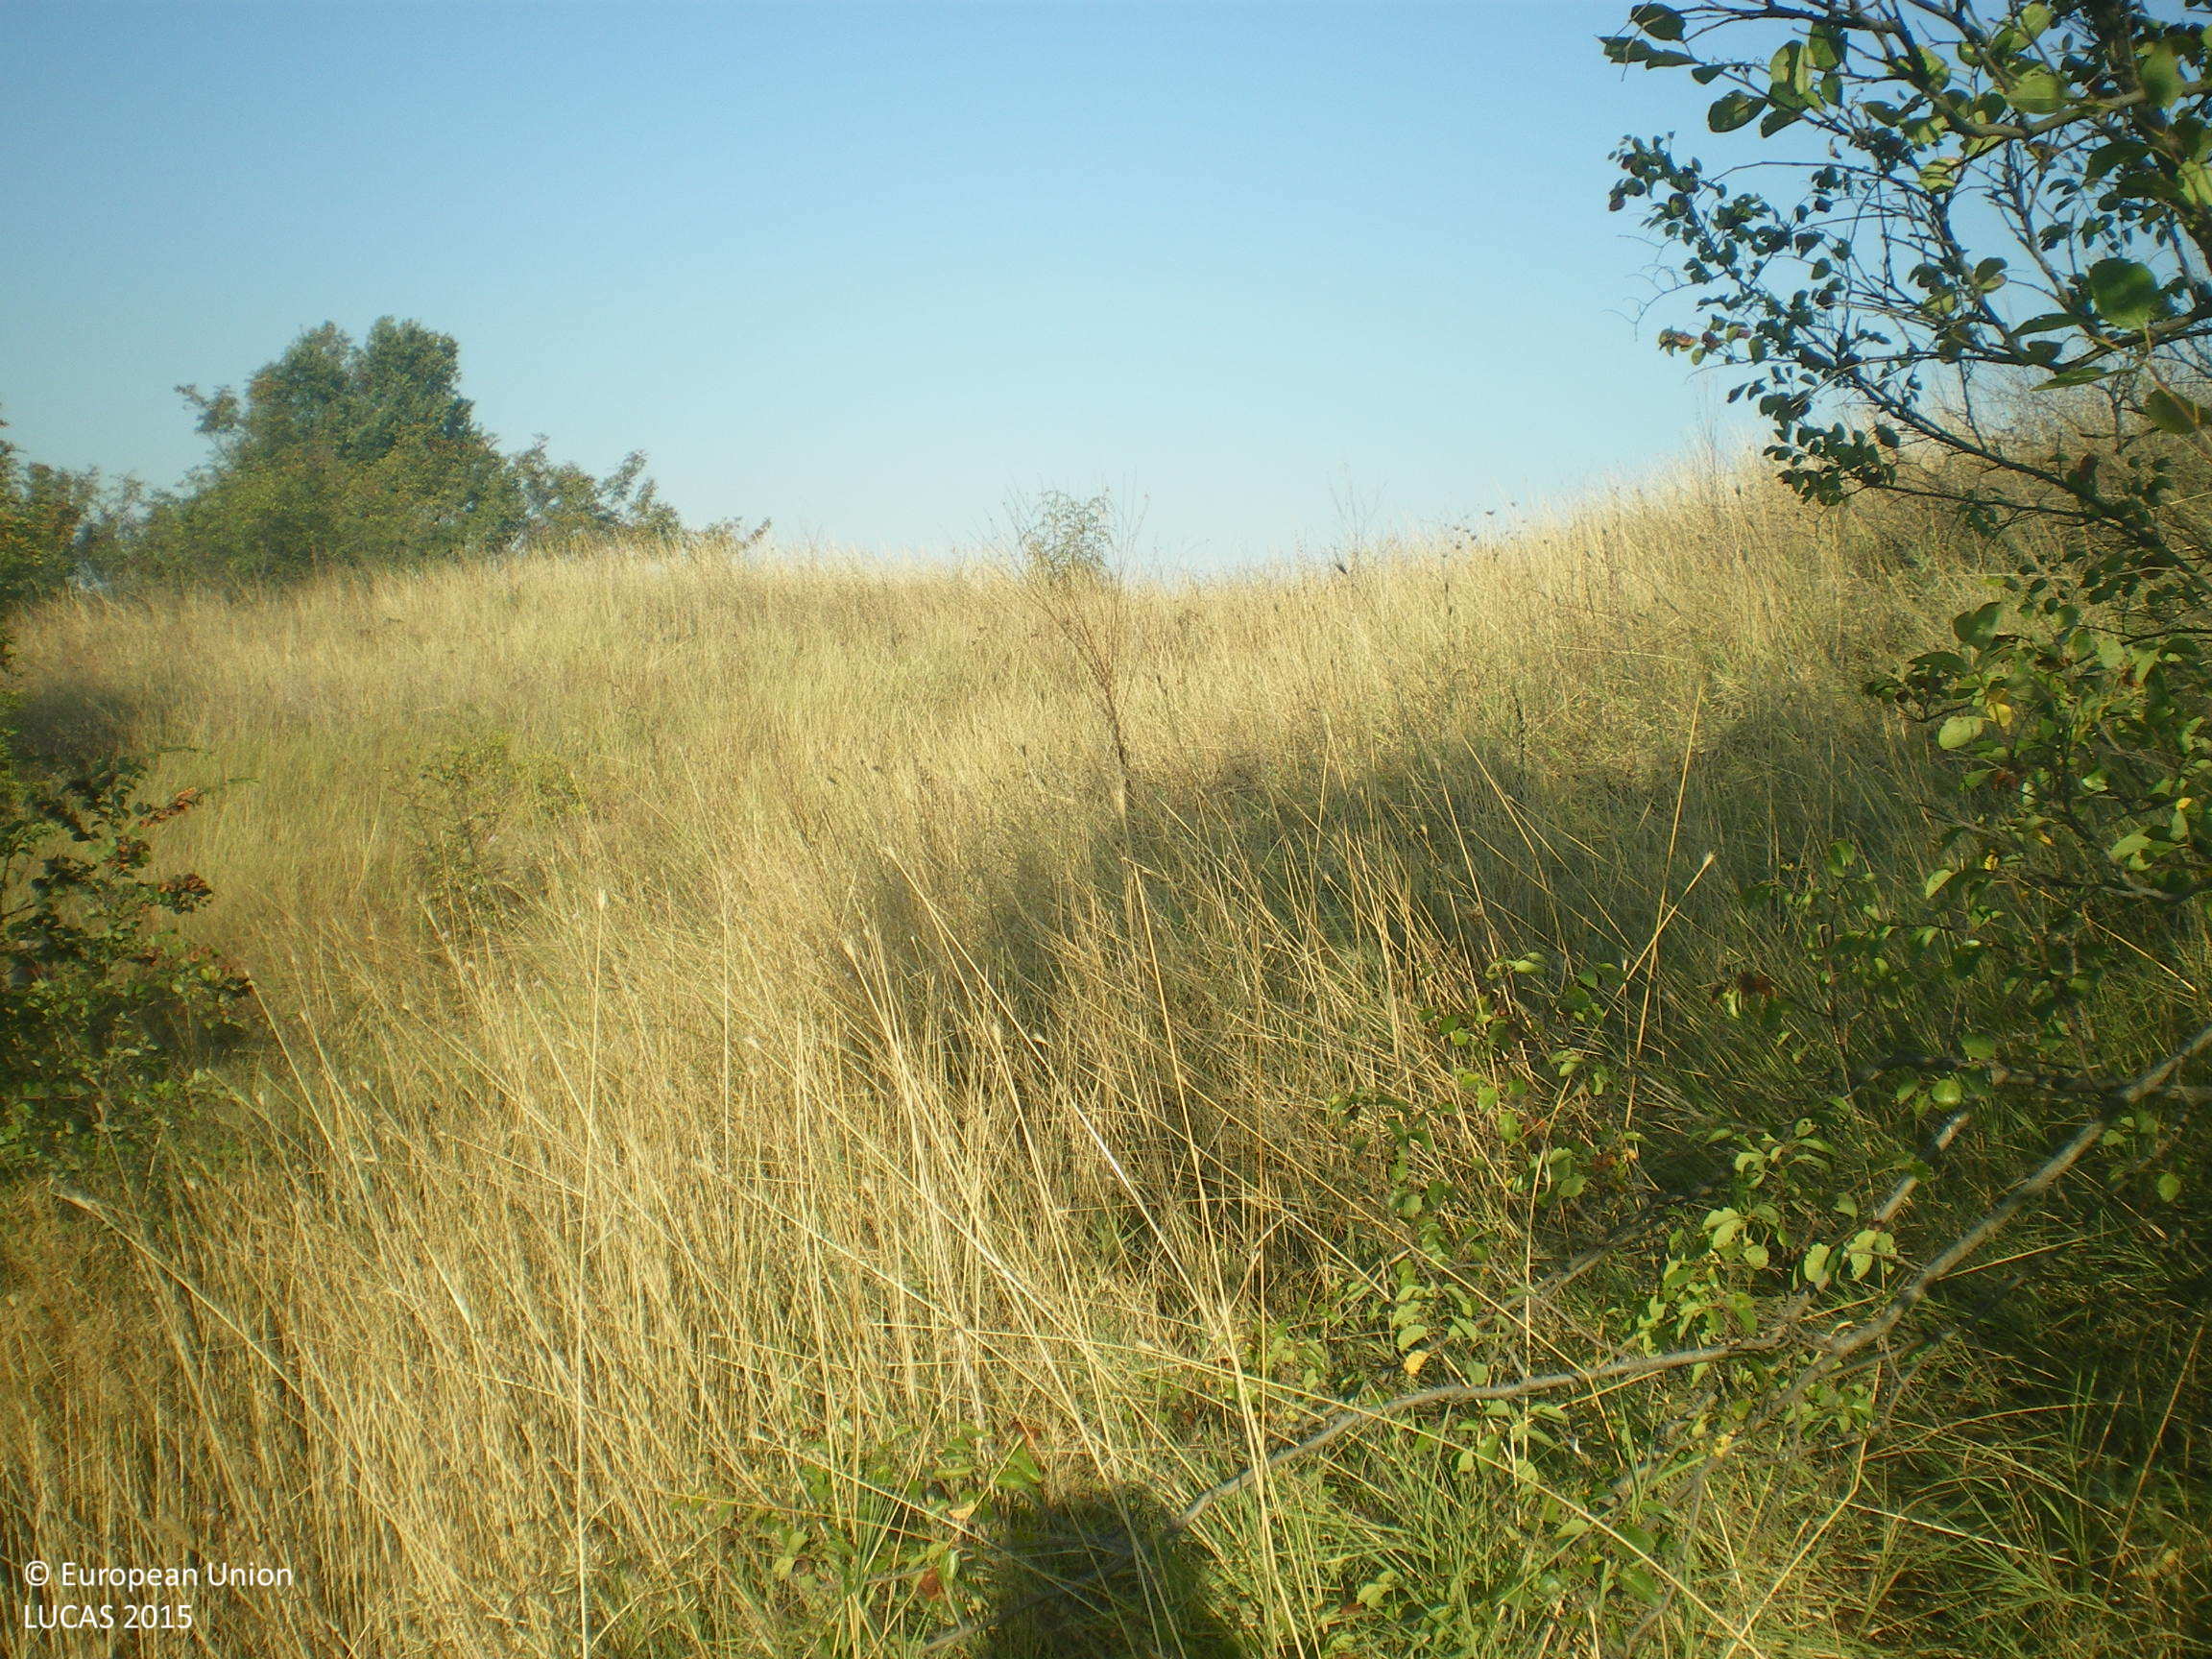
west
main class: Grassland
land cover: Grassland with sparse tree/shrub cover
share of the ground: > 75 %
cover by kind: herbaceous plants 90 %, broadleaved forest trees 5 %, shrubs 5 %
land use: Agriculture (excluding fallow land and kitchen gardens)
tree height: > 5 m
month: August
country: BG
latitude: 42.0480
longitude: 25.9125
